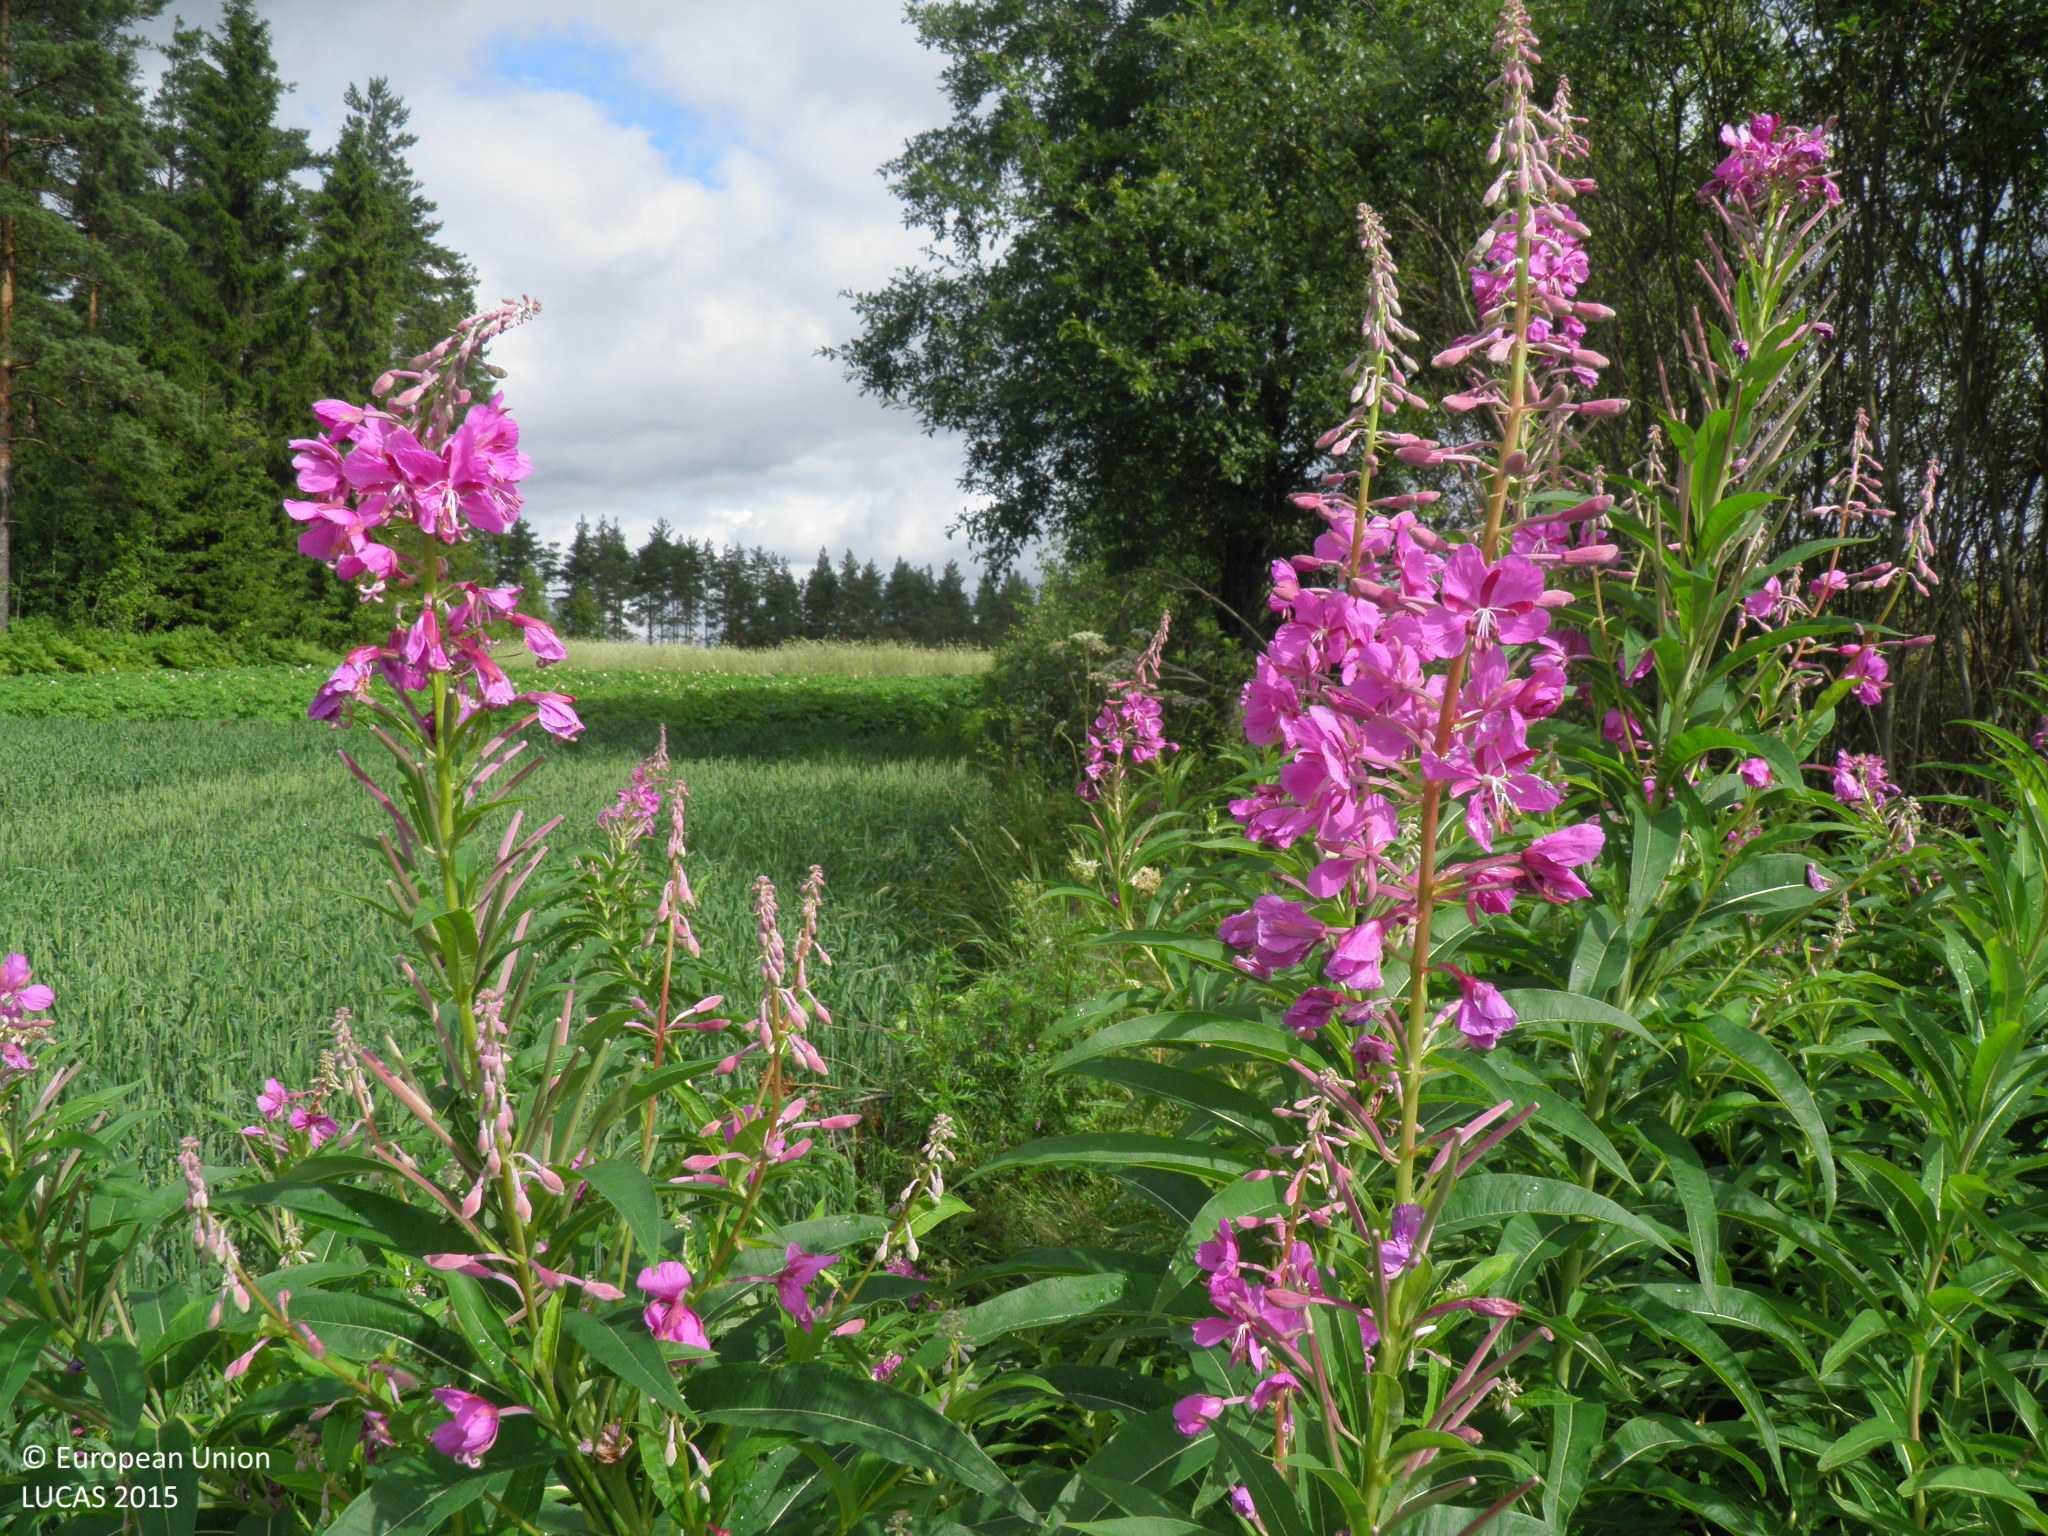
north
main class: Cropland
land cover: Common wheat
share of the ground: > 75 %
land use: Agriculture (excluding fallow land and kitchen gardens)
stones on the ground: < 10 %
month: July
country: FI
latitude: 60.1547
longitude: 22.6670
